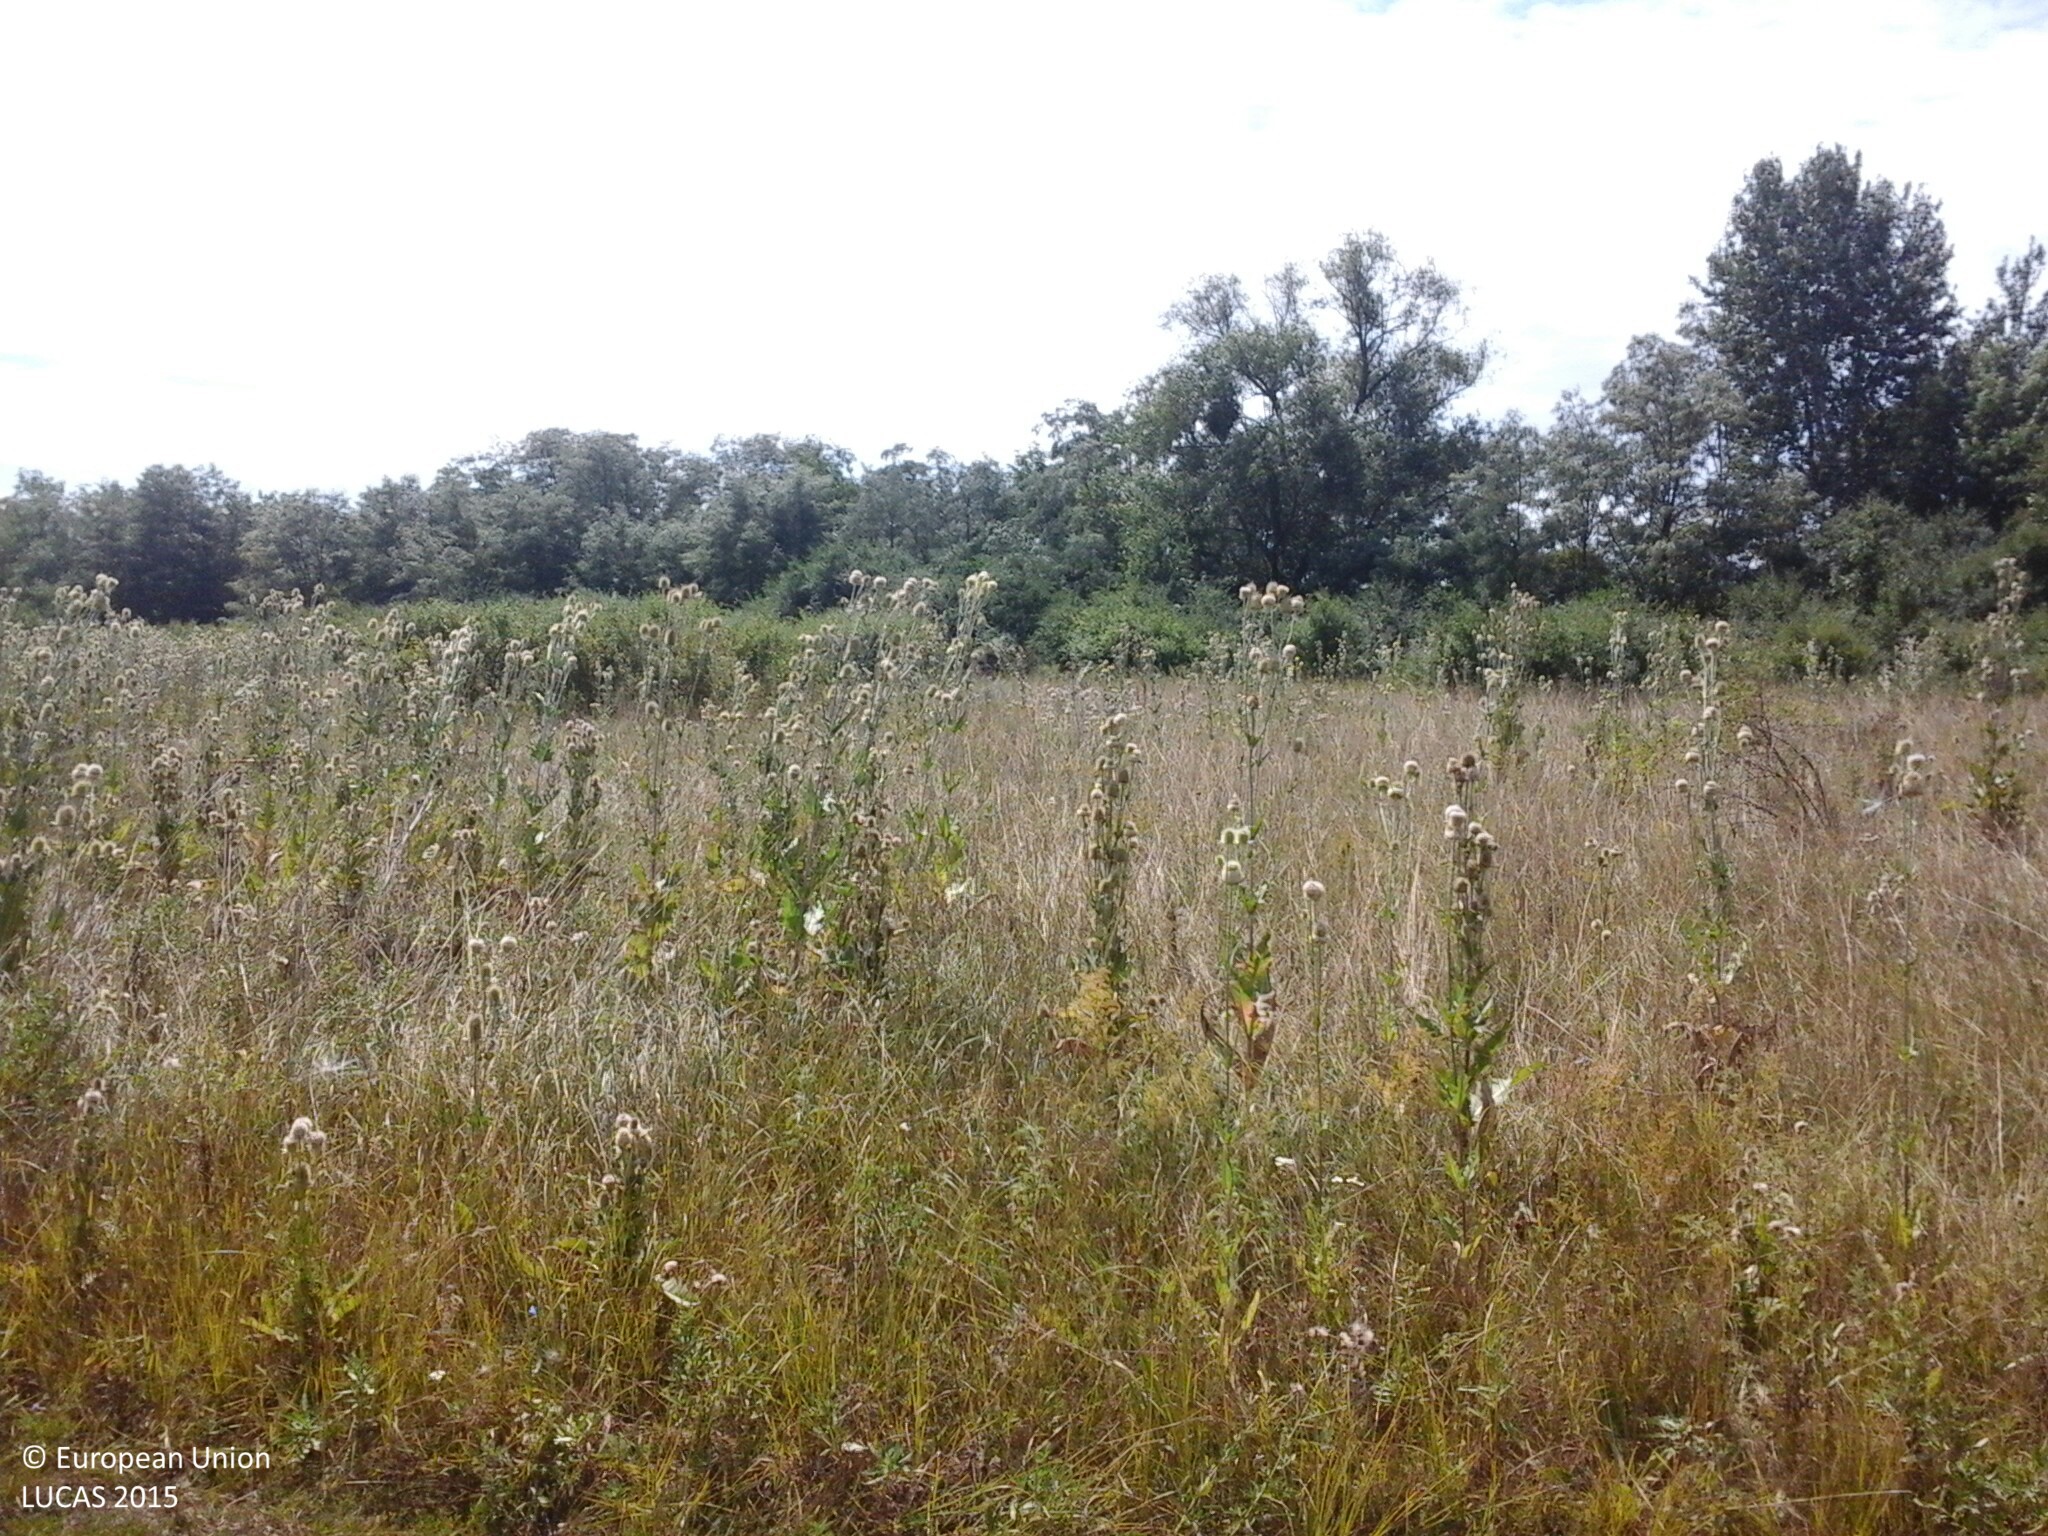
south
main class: Grassland
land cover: Spontaneously vegetated surfaces
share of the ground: > 75 %
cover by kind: herbaceous plants 100 %
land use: Semi-natural and natural areas not in use
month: July
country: HU
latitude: 48.0466
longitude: 22.4133
